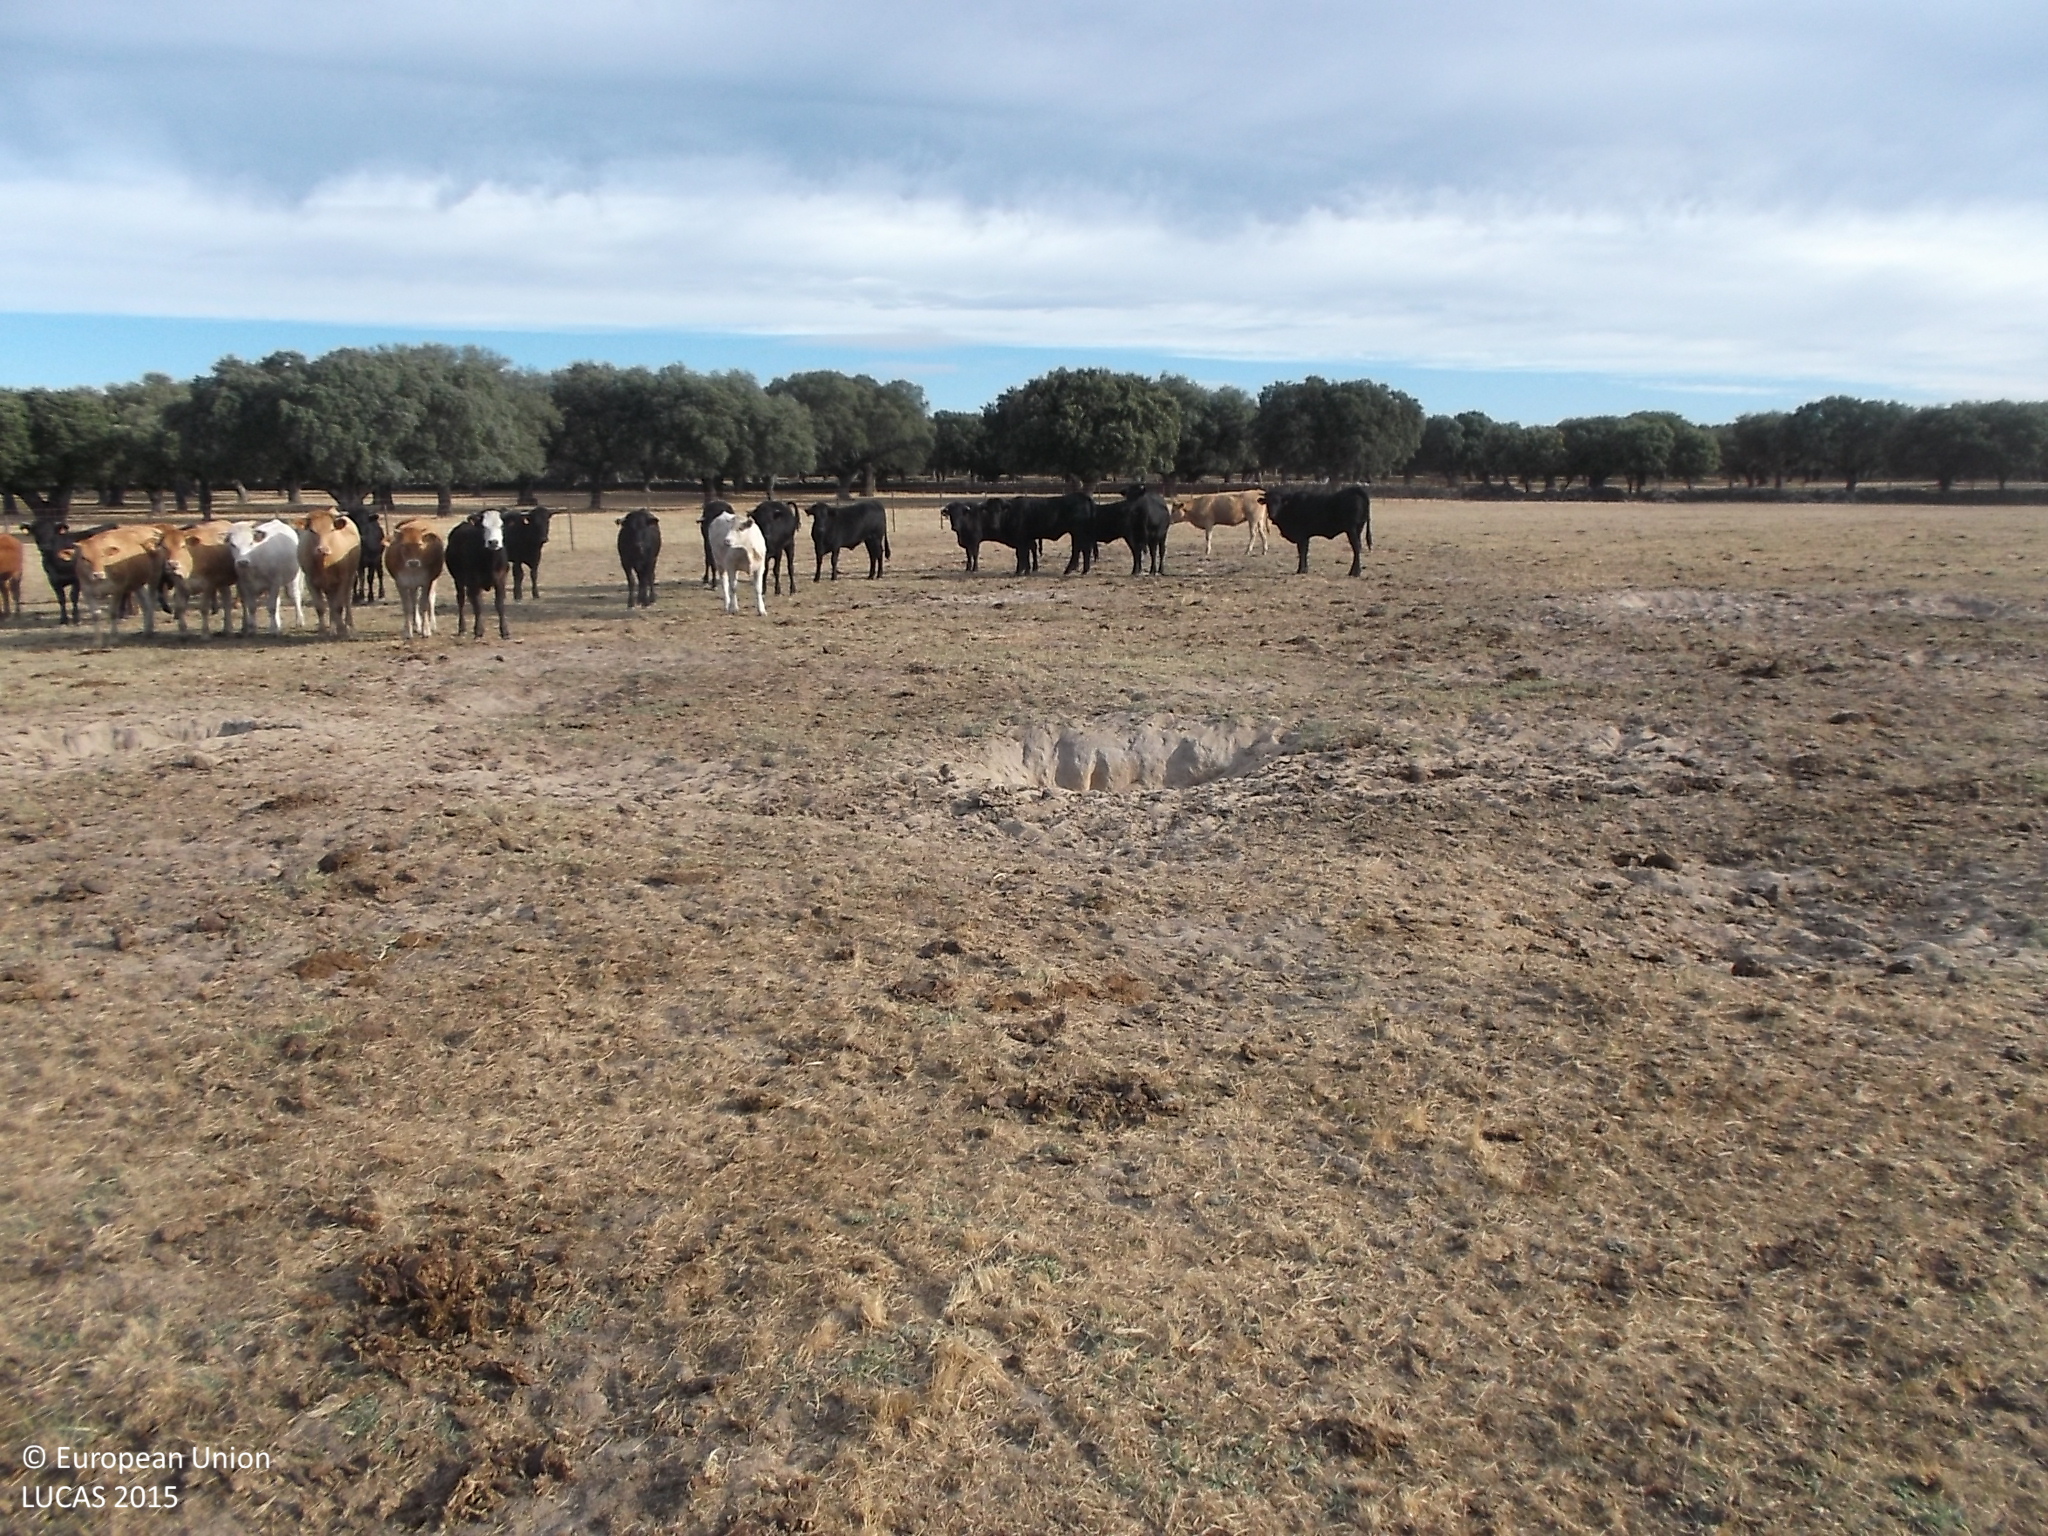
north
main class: Grassland
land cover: Grassland without tree/shrub cover
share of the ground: > 75 %
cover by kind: herbaceous plants 100 %
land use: Agriculture (excluding fallow land and kitchen gardens)
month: July
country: ES
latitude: 40.8309
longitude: -6.2743
